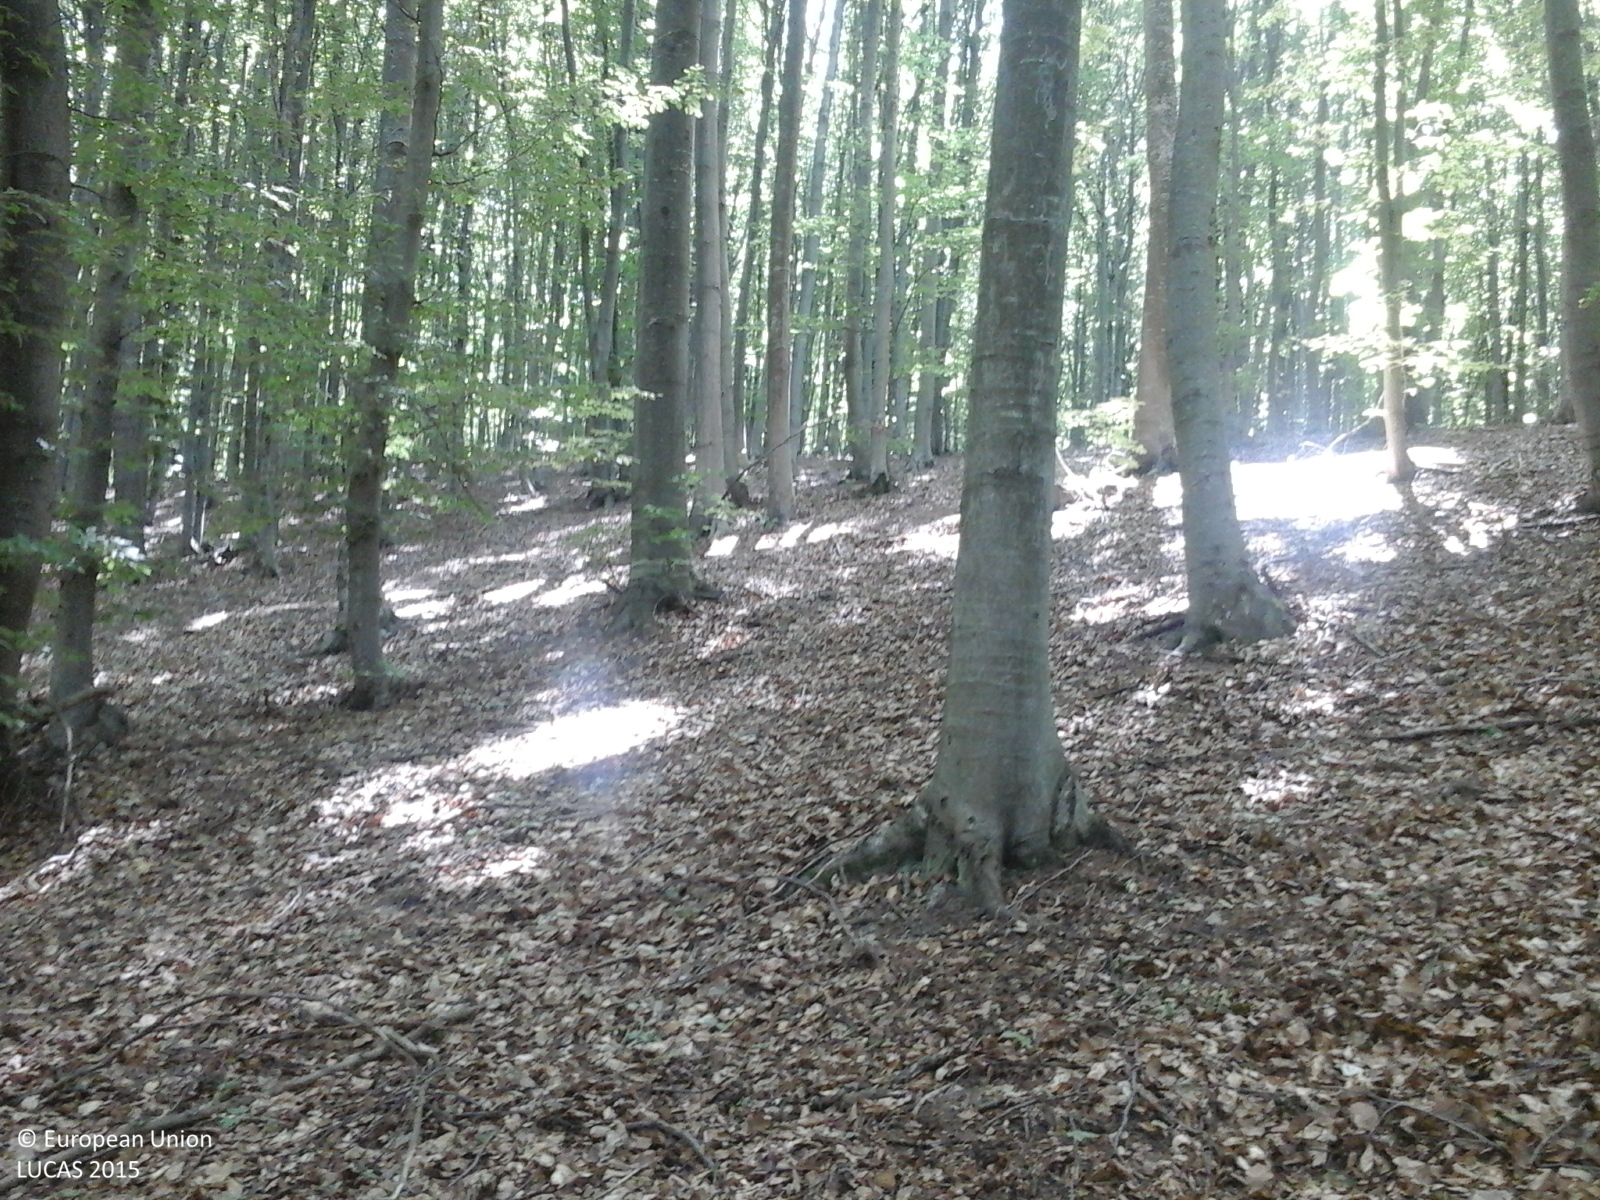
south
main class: Woodland
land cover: Broadleaved woodland
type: beech forest
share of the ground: > 75 %
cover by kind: broadleaved forest trees 100 %
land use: Forestry
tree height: > 5 m
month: June
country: RO
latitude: 46.5544
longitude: 26.7990
